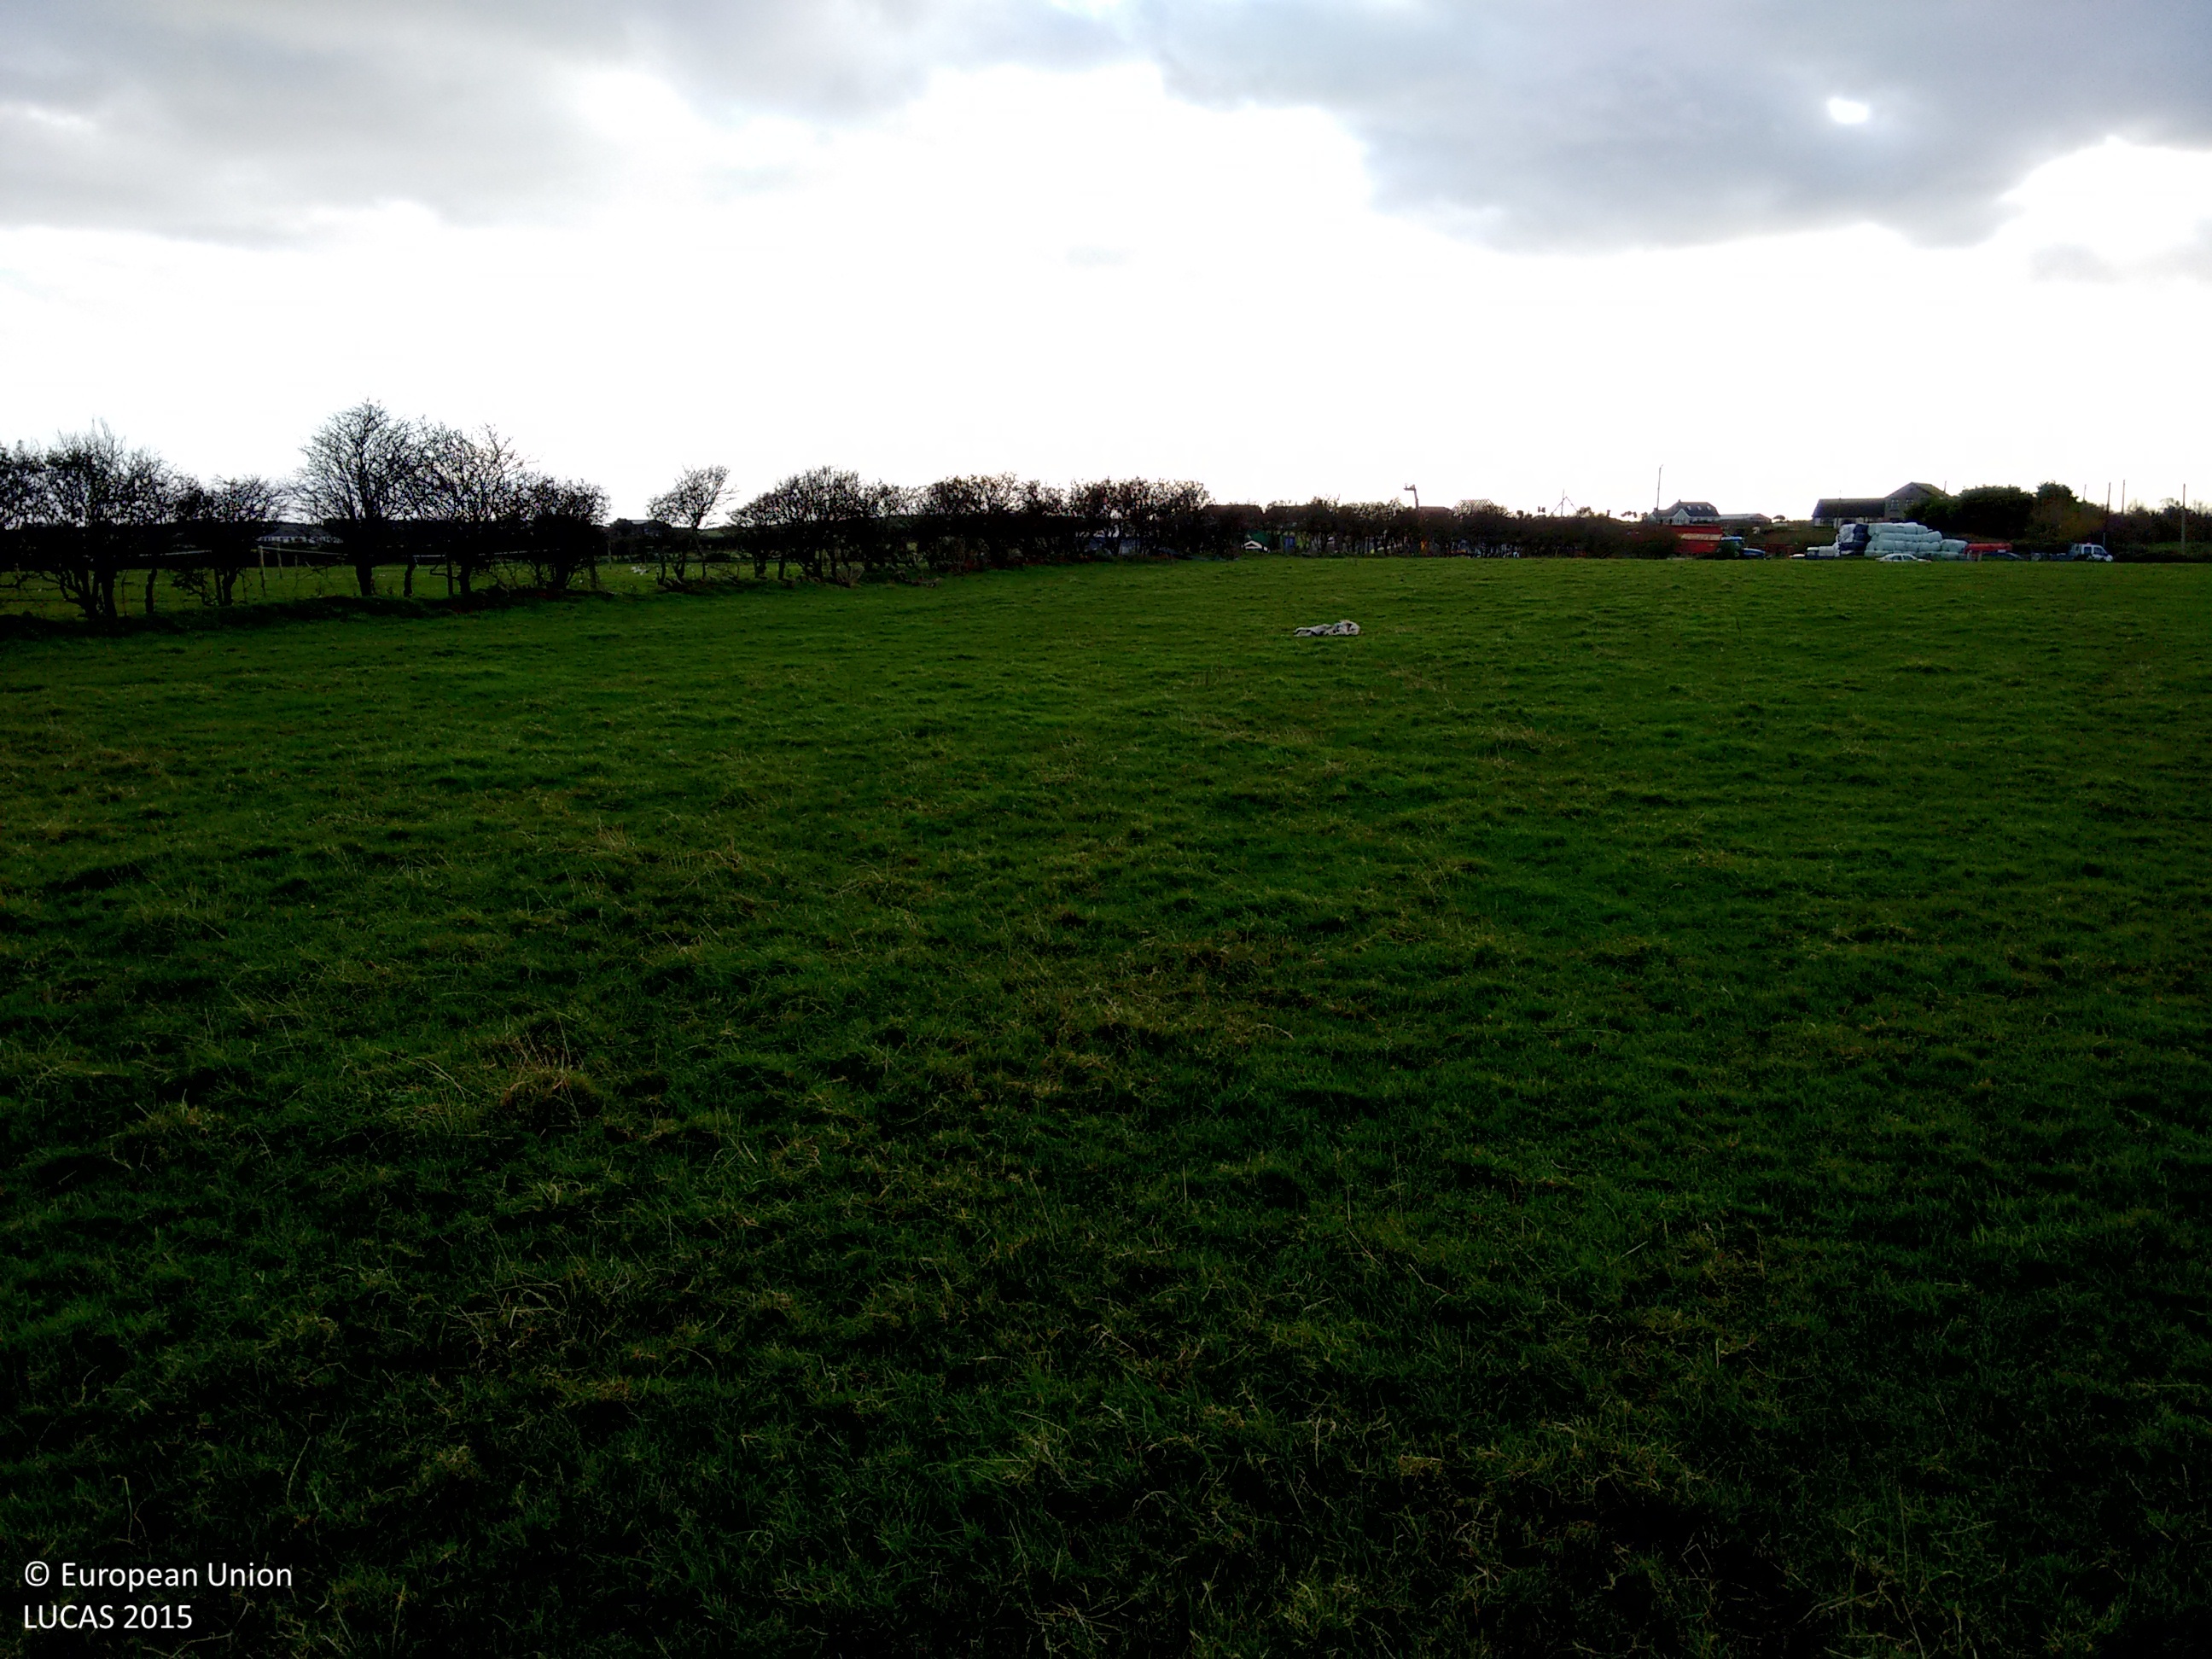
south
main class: Grassland
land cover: Grassland without tree/shrub cover
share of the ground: > 75 %
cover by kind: herbaceous plants 100 %
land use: Agriculture (excluding fallow land and kitchen gardens)
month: November
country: GB
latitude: 54.4908
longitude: -5.4561
